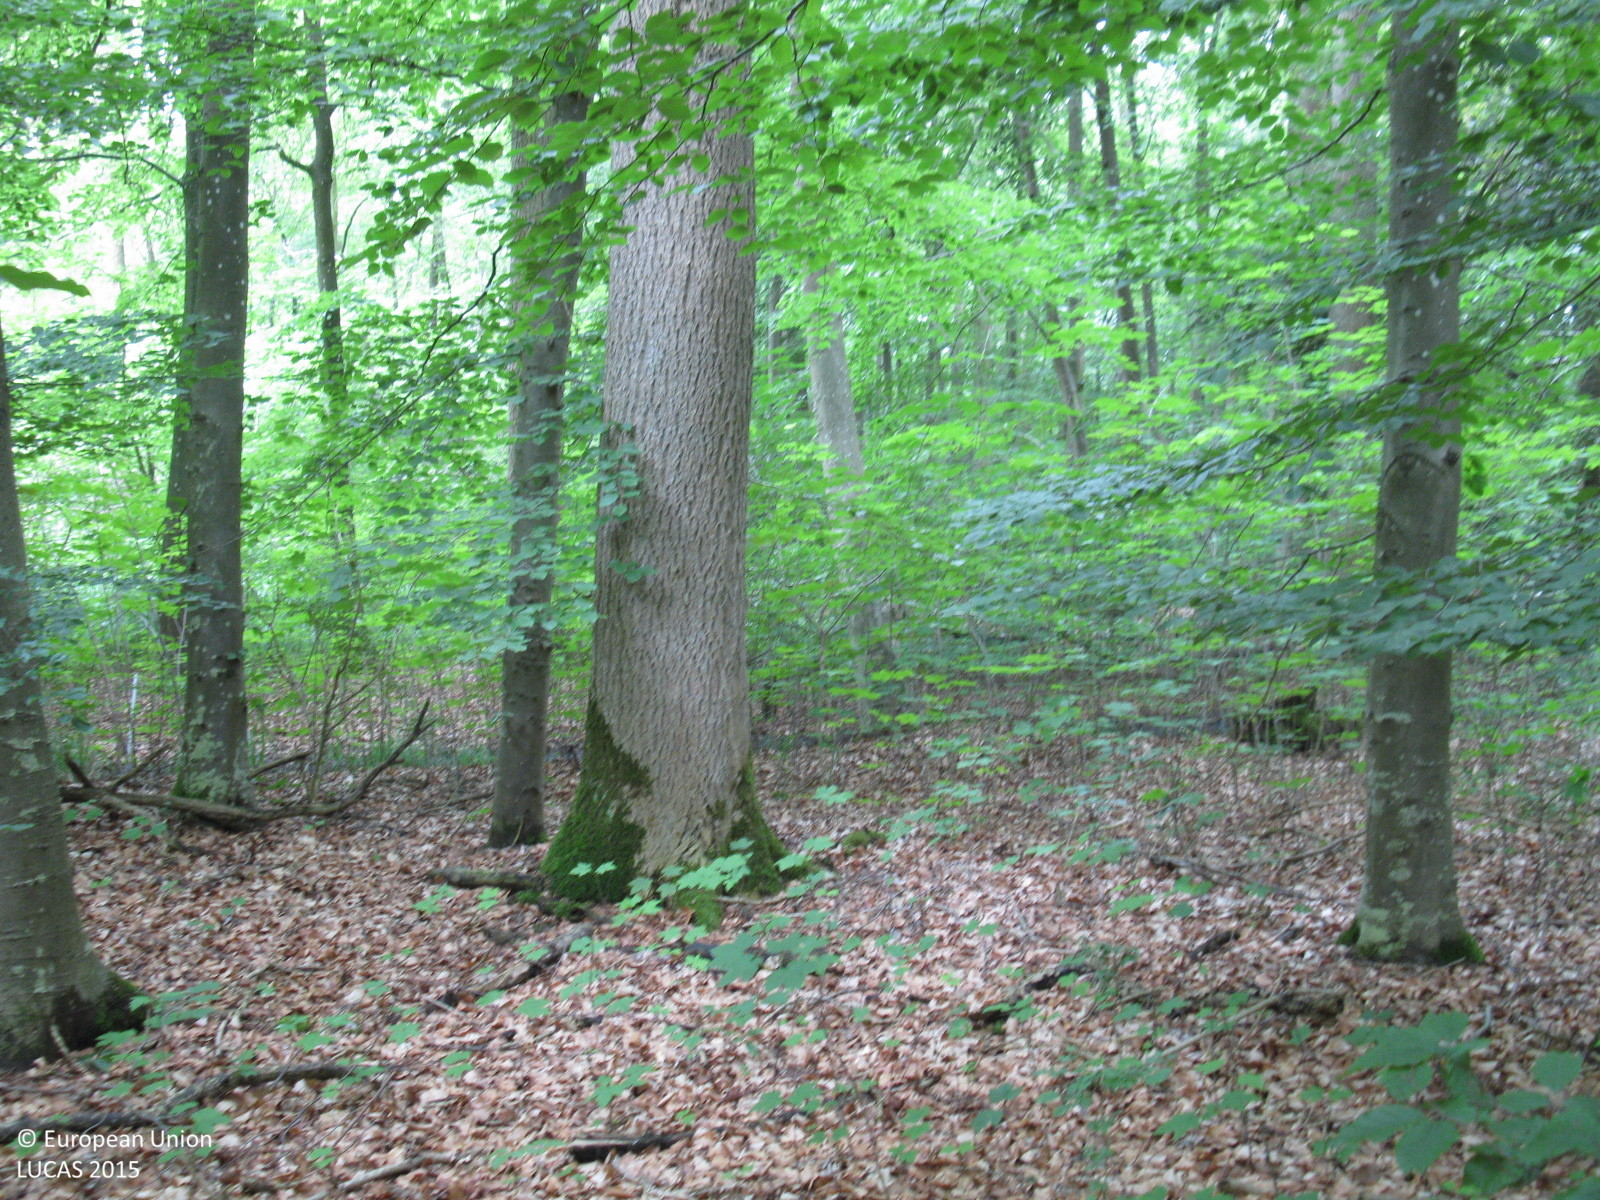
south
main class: Woodland
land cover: Broadleaved woodland
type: beech forest
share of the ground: > 75 %
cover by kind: broadleaved forest trees 100 %
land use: Forestry
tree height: > 5 m
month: June
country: DE
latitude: 53.5276
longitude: 7.9039
